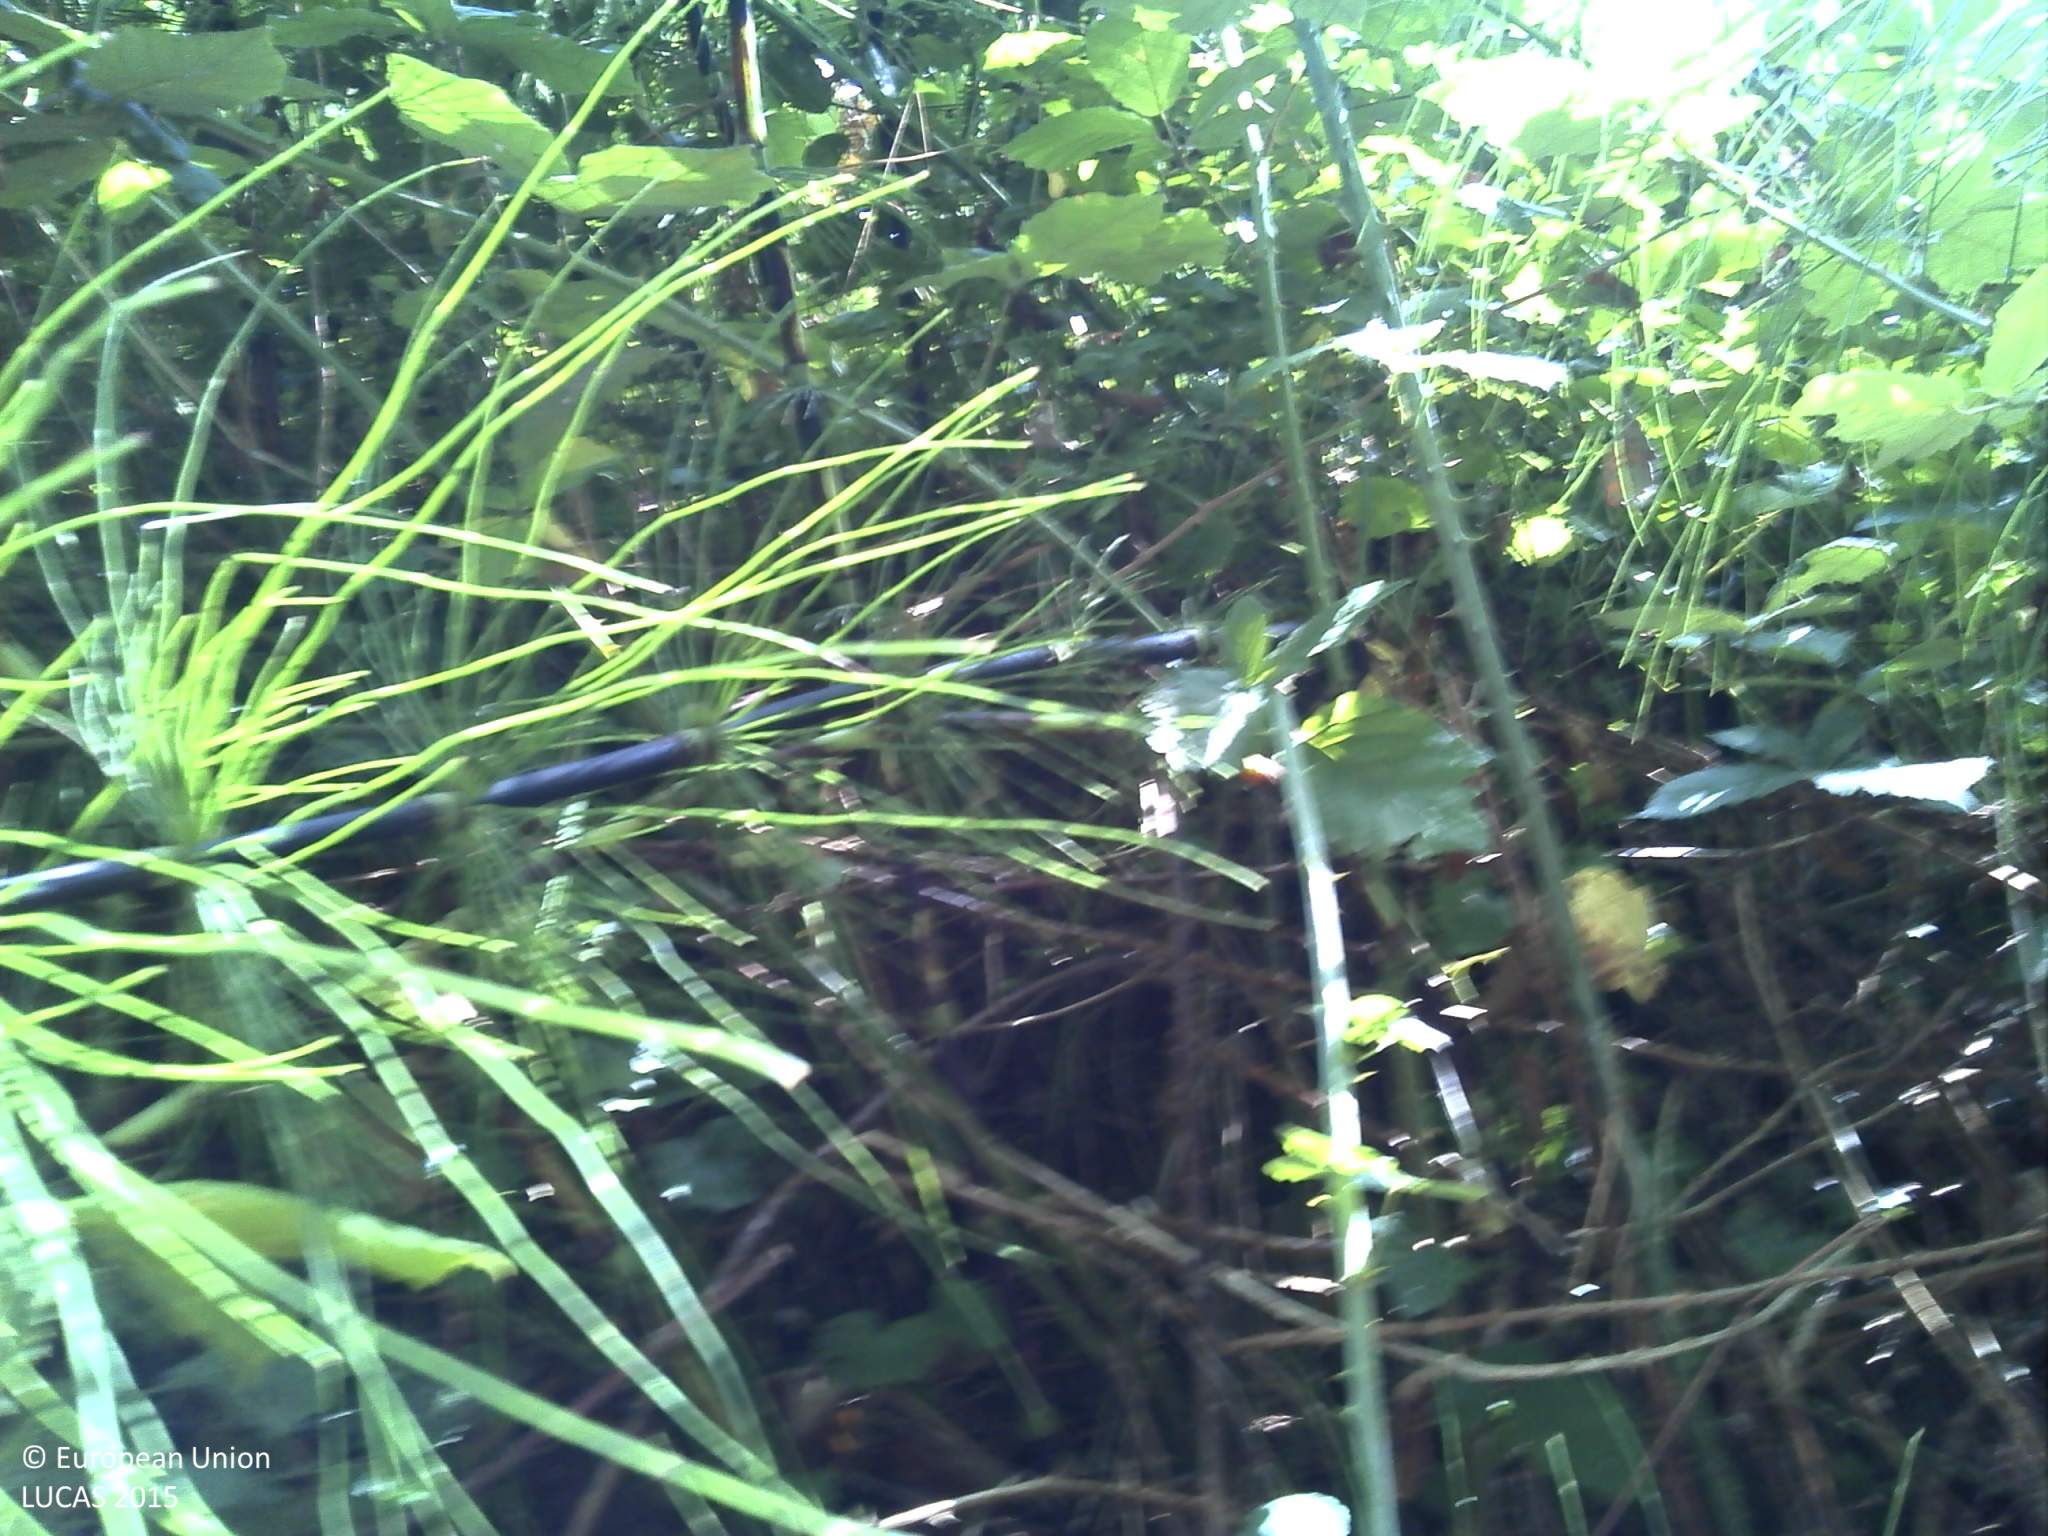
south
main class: Woodland
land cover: Broadleaved woodland
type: floodplain forest
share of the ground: > 75 %
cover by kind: broadleaved forest trees 100 %
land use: Semi-natural and natural areas not in use
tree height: > 5 m
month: August
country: FR
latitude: 45.0169
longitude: -0.6670
